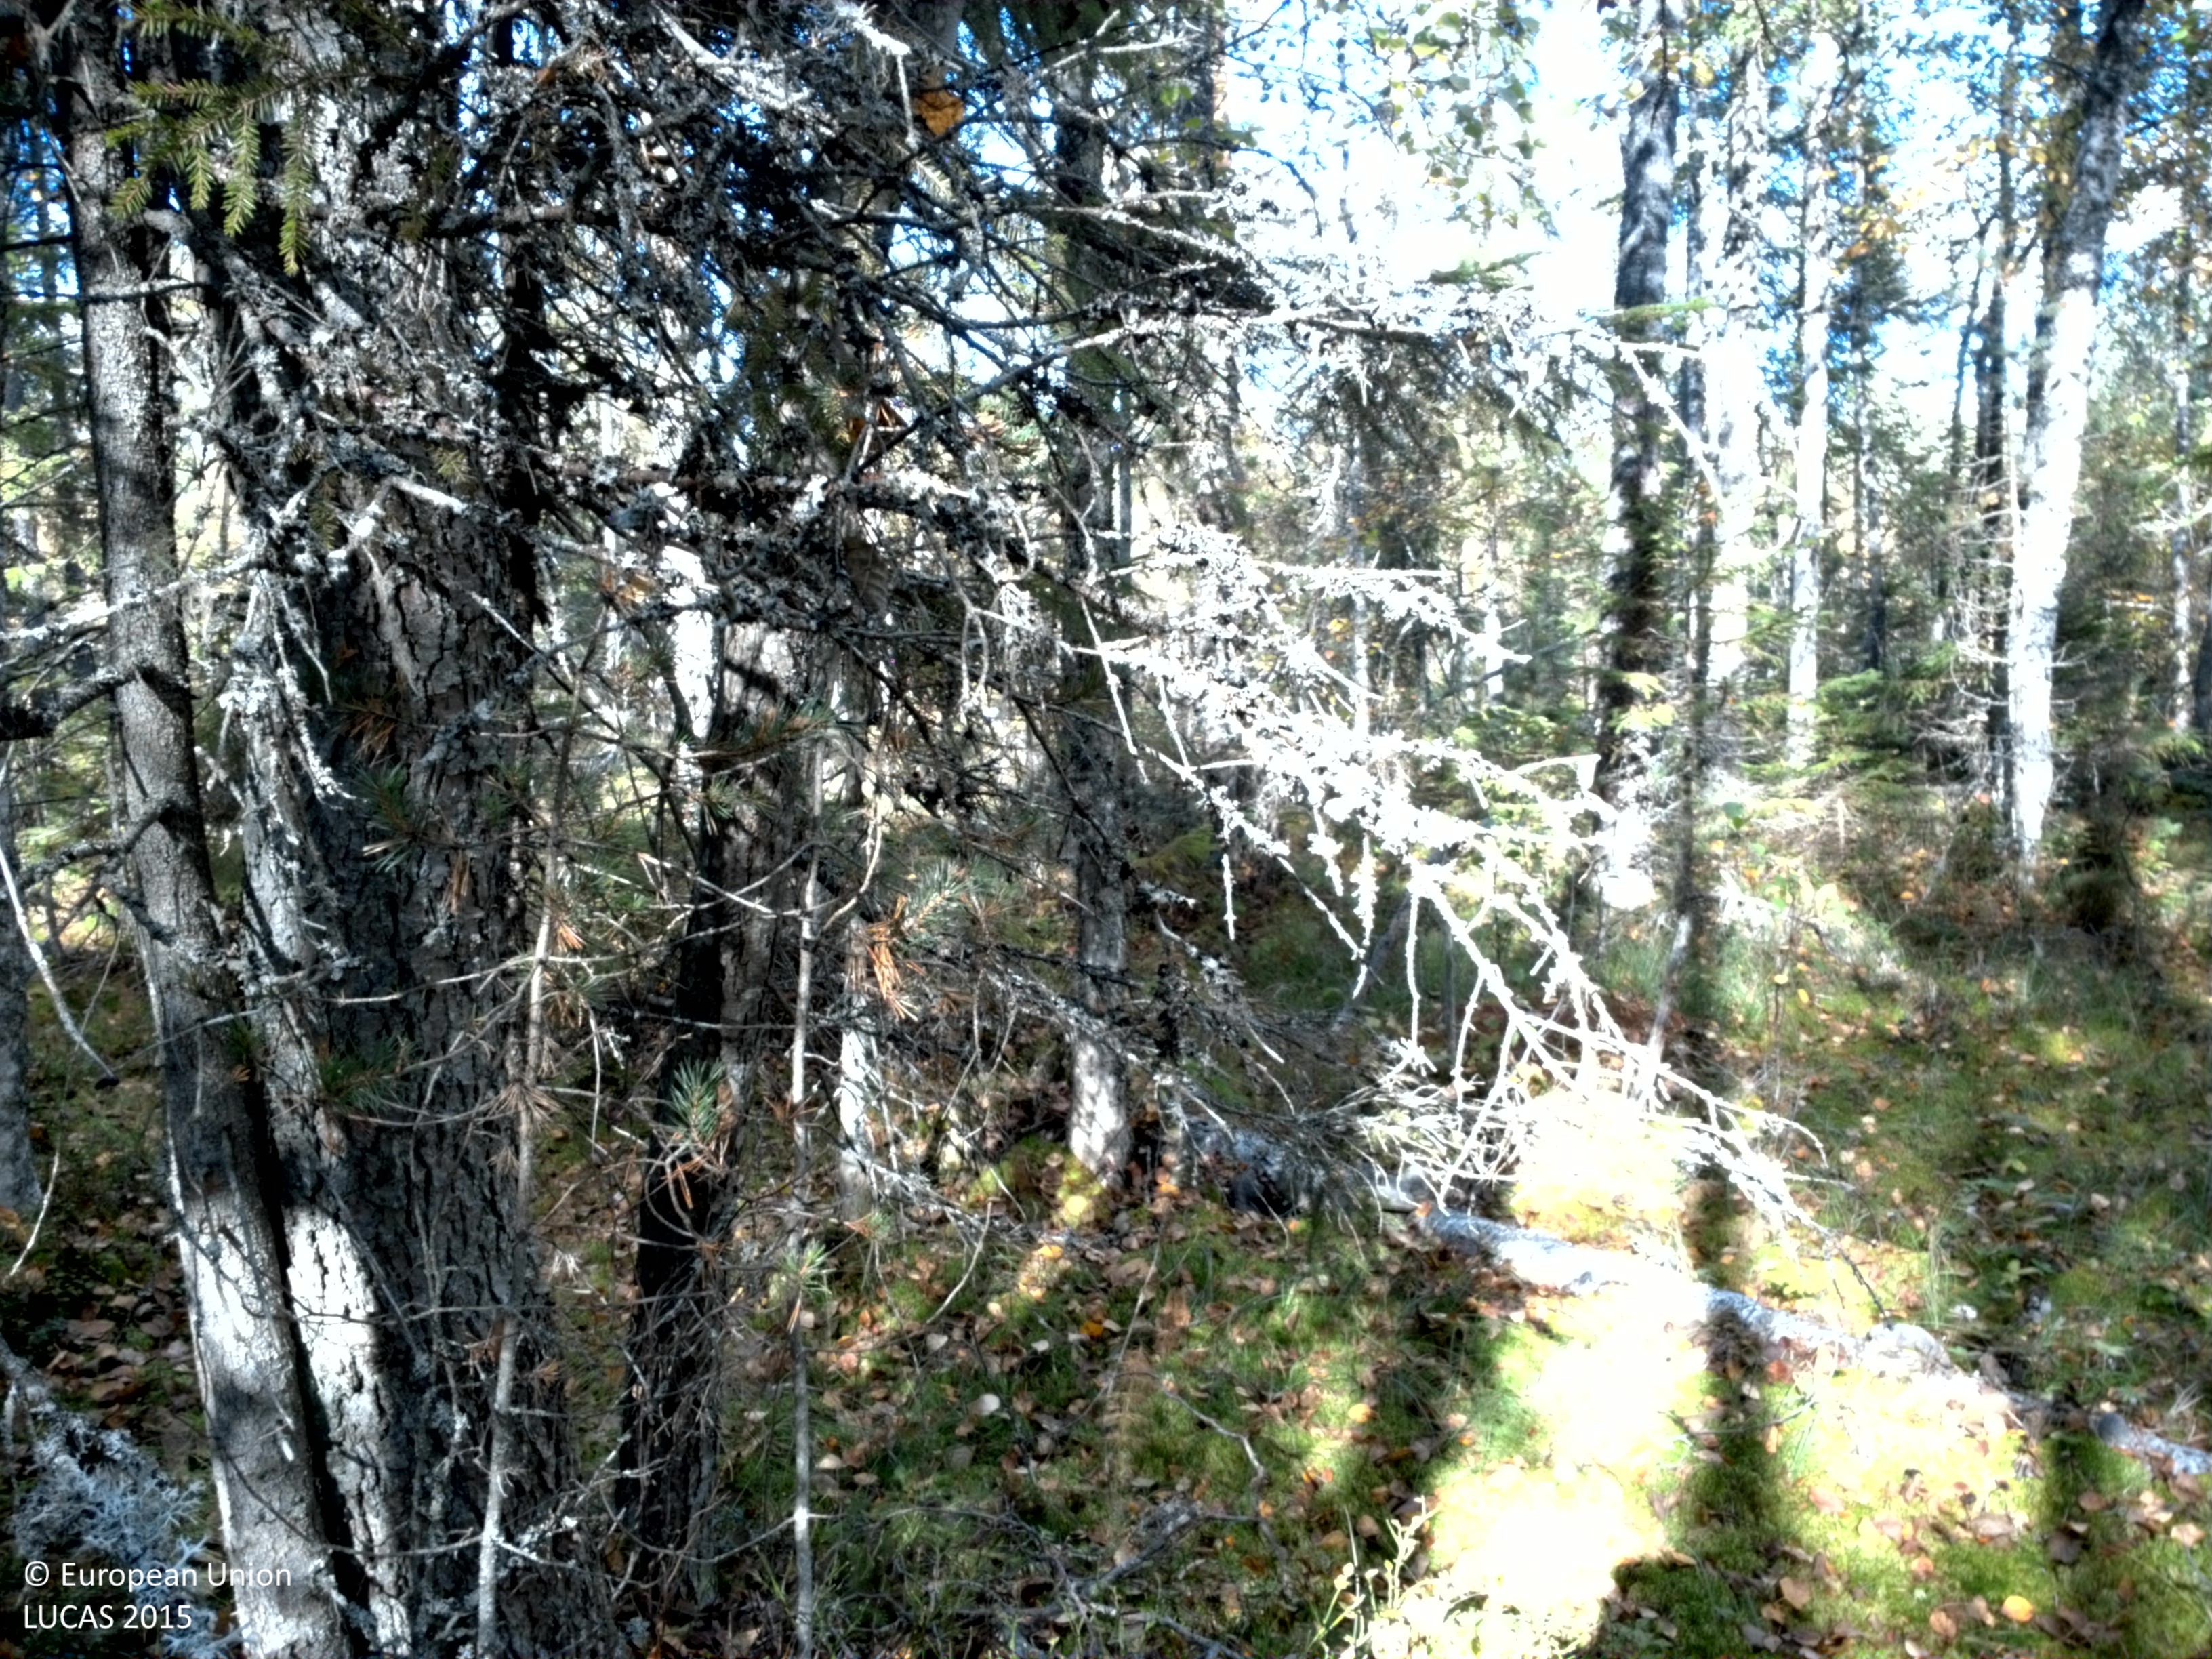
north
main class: Woodland
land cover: Spruce dominated mixed woodland
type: mire and swamp forests
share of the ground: 50 - 75 %
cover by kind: coniferous forest trees 45 %, lichens and mosses 40 %, broadleaved forest trees 15 %
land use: Forestry
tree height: > 5 m
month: September
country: SE
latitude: 60.1381
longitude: 16.5260
